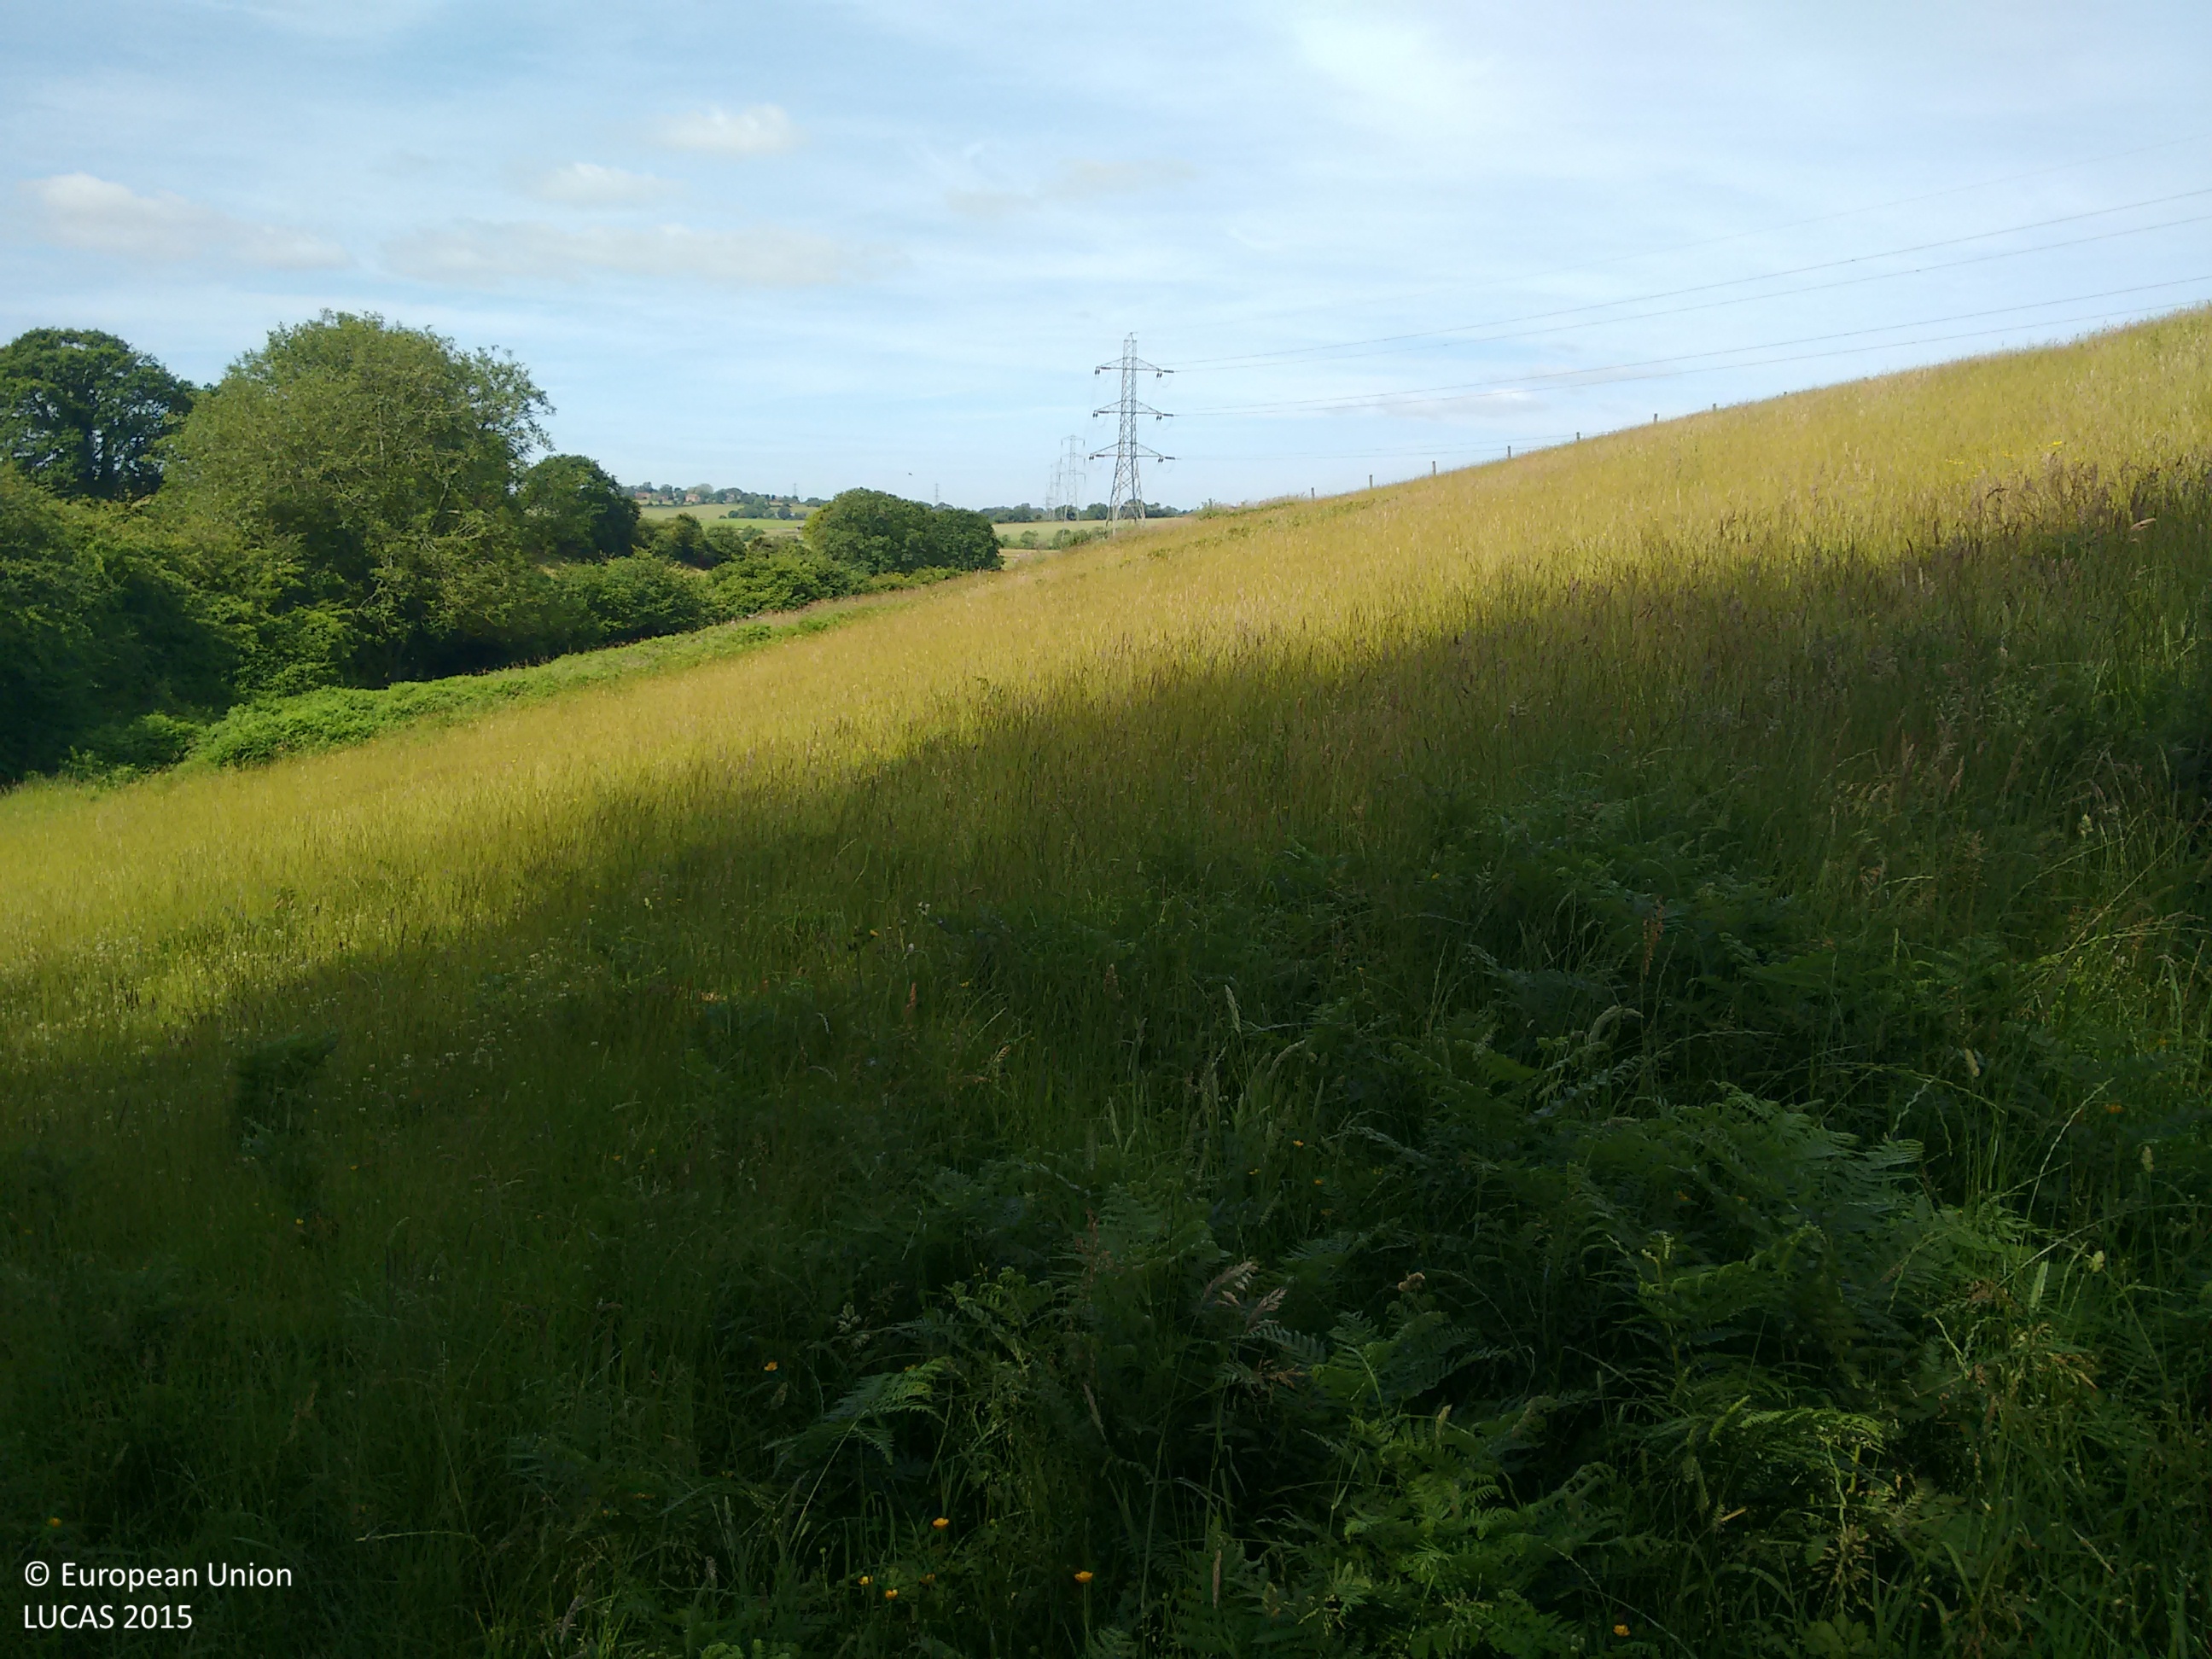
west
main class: Grassland
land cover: Grassland with sparse tree/shrub cover
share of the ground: > 75 %
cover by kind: herbaceous plants 85 %, shrubs 10 %, broadleaved forest trees 5 %
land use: Agriculture (excluding fallow land and kitchen gardens)
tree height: > 5 m
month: June
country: GB
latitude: 50.8633
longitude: 0.3808
